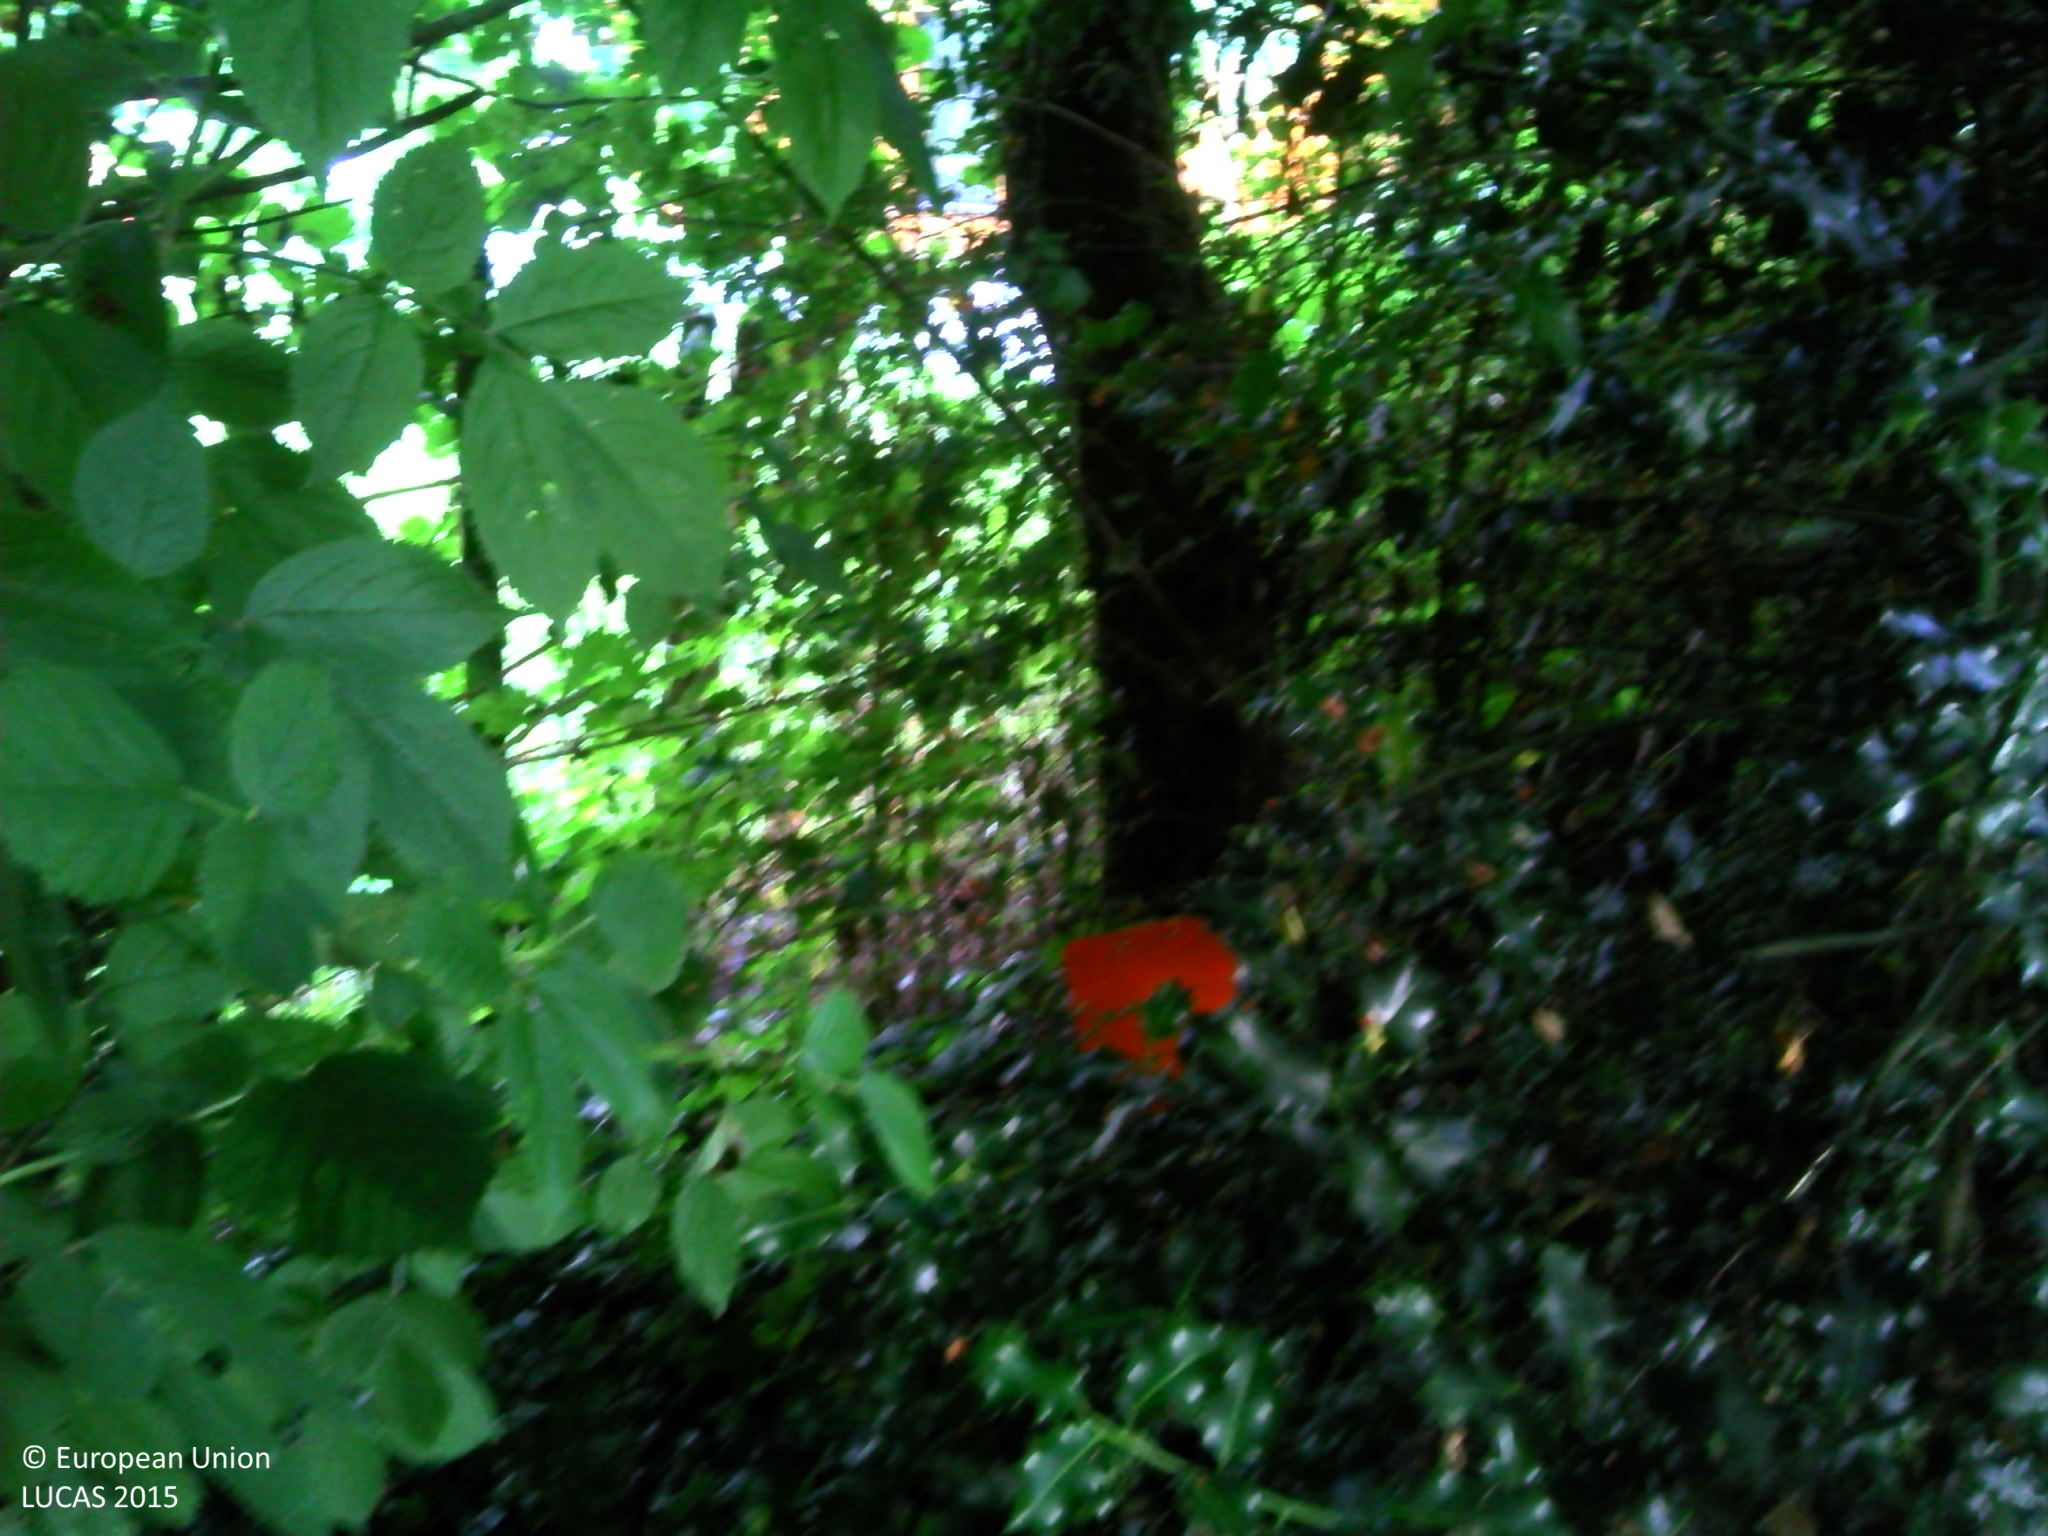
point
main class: Woodland
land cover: Broadleaved woodland
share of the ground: > 75 %
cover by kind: broadleaved forest trees 90 %, herbaceous plants 10 %
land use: Residential
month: July
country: FR
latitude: 47.5180
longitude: -1.9341
